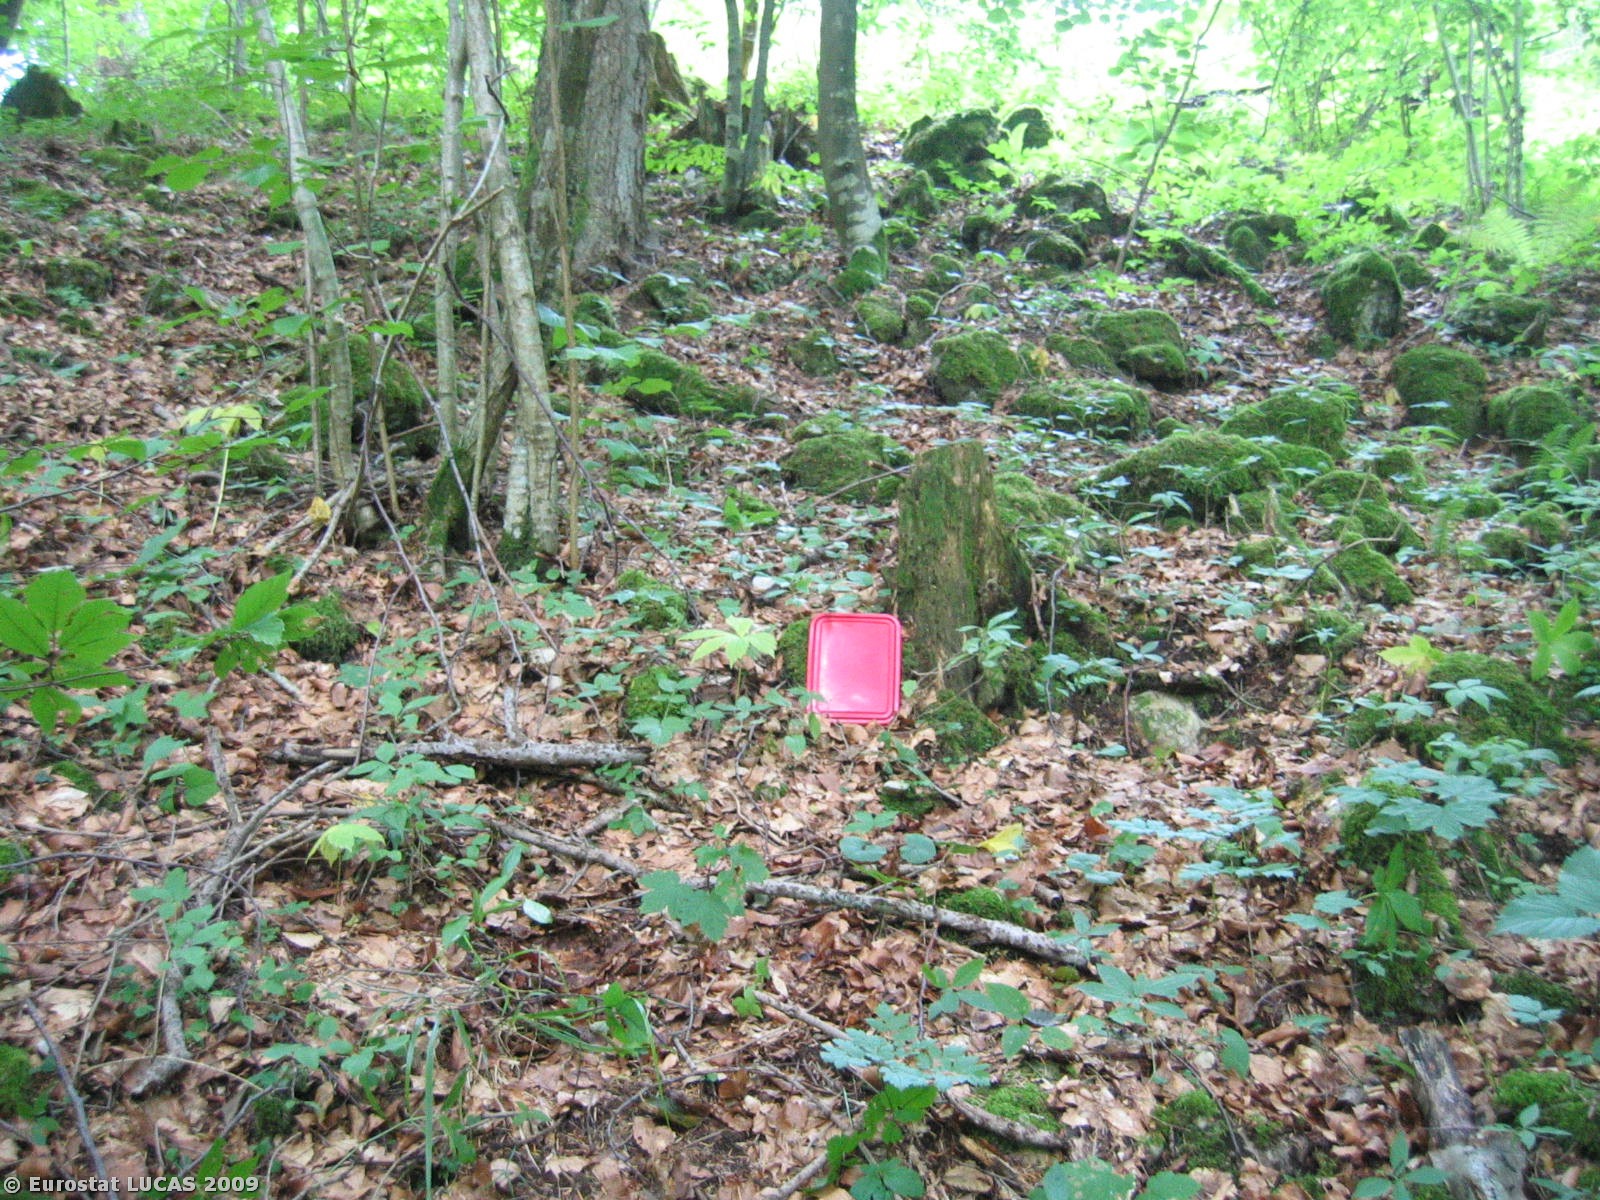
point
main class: Woodland
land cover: Mixed woodland
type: mountainous beech forest
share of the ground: > 75 %
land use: Forestry
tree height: > 5 m
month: August
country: SI
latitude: 45.8844
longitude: 14.3385
